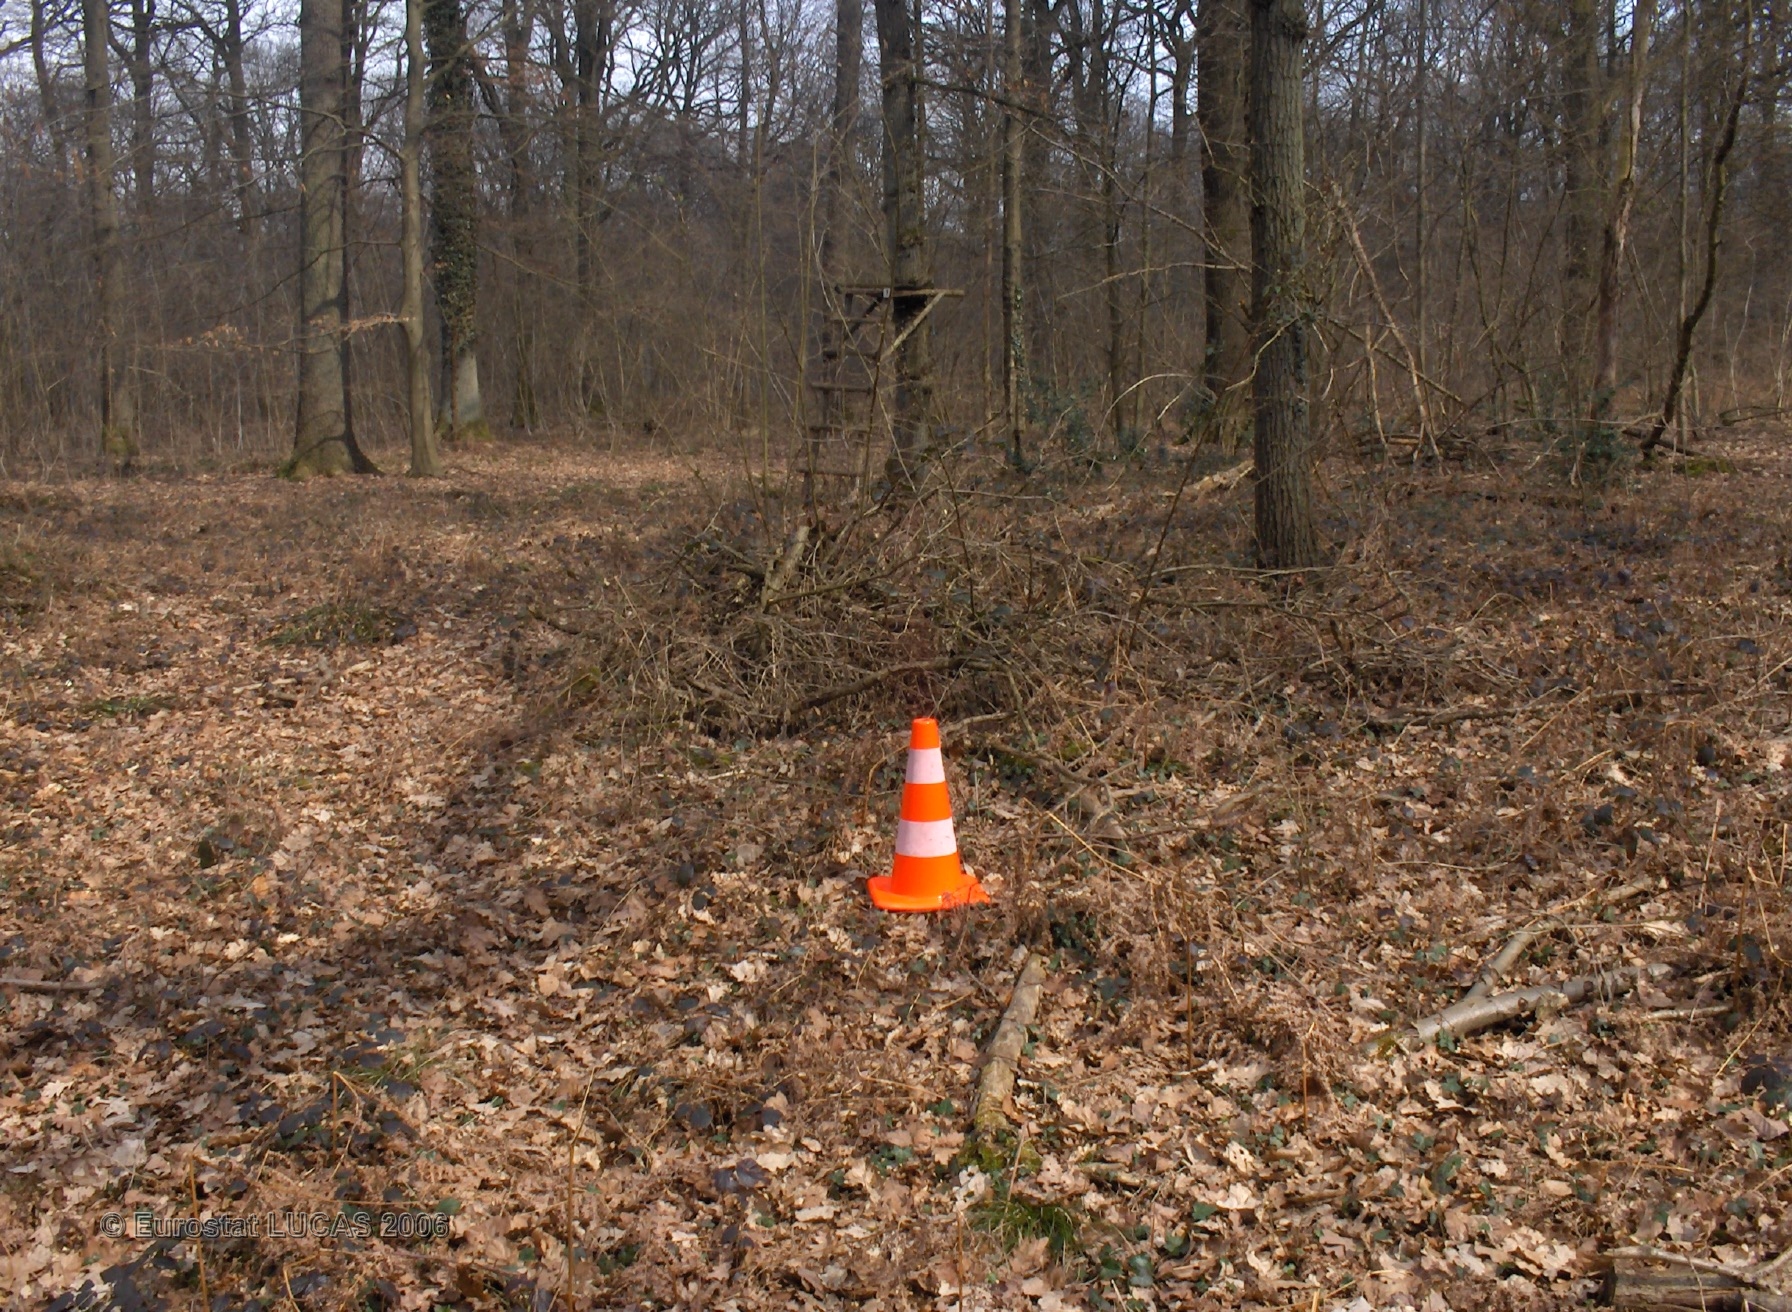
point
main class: Woodland
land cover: Mixed forest
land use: Forestry
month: April
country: BE
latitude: 50.3785
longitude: 4.5540
